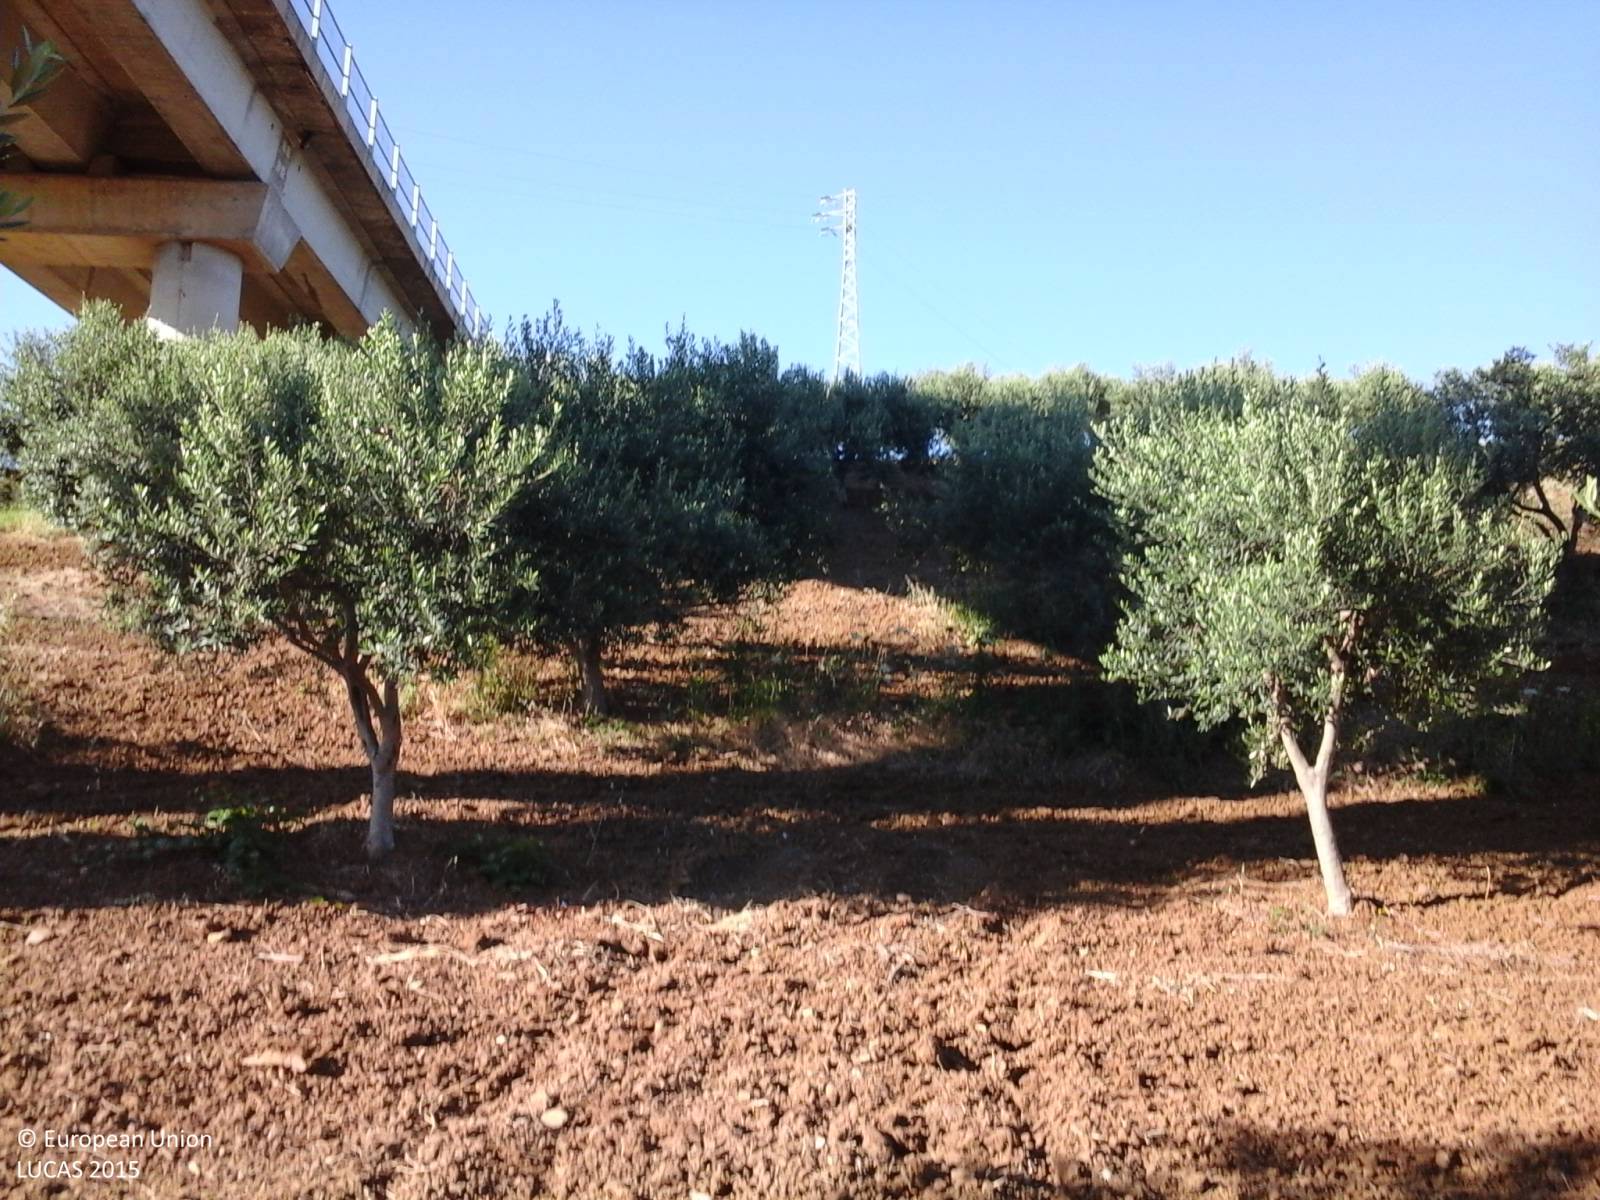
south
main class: Cropland
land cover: Olive groves
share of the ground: 25 - 50 %
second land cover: Other bare soil
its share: > 75 %
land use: Agriculture (excluding fallow land and kitchen gardens)
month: June
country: IT
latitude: 37.9749
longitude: 12.9273
